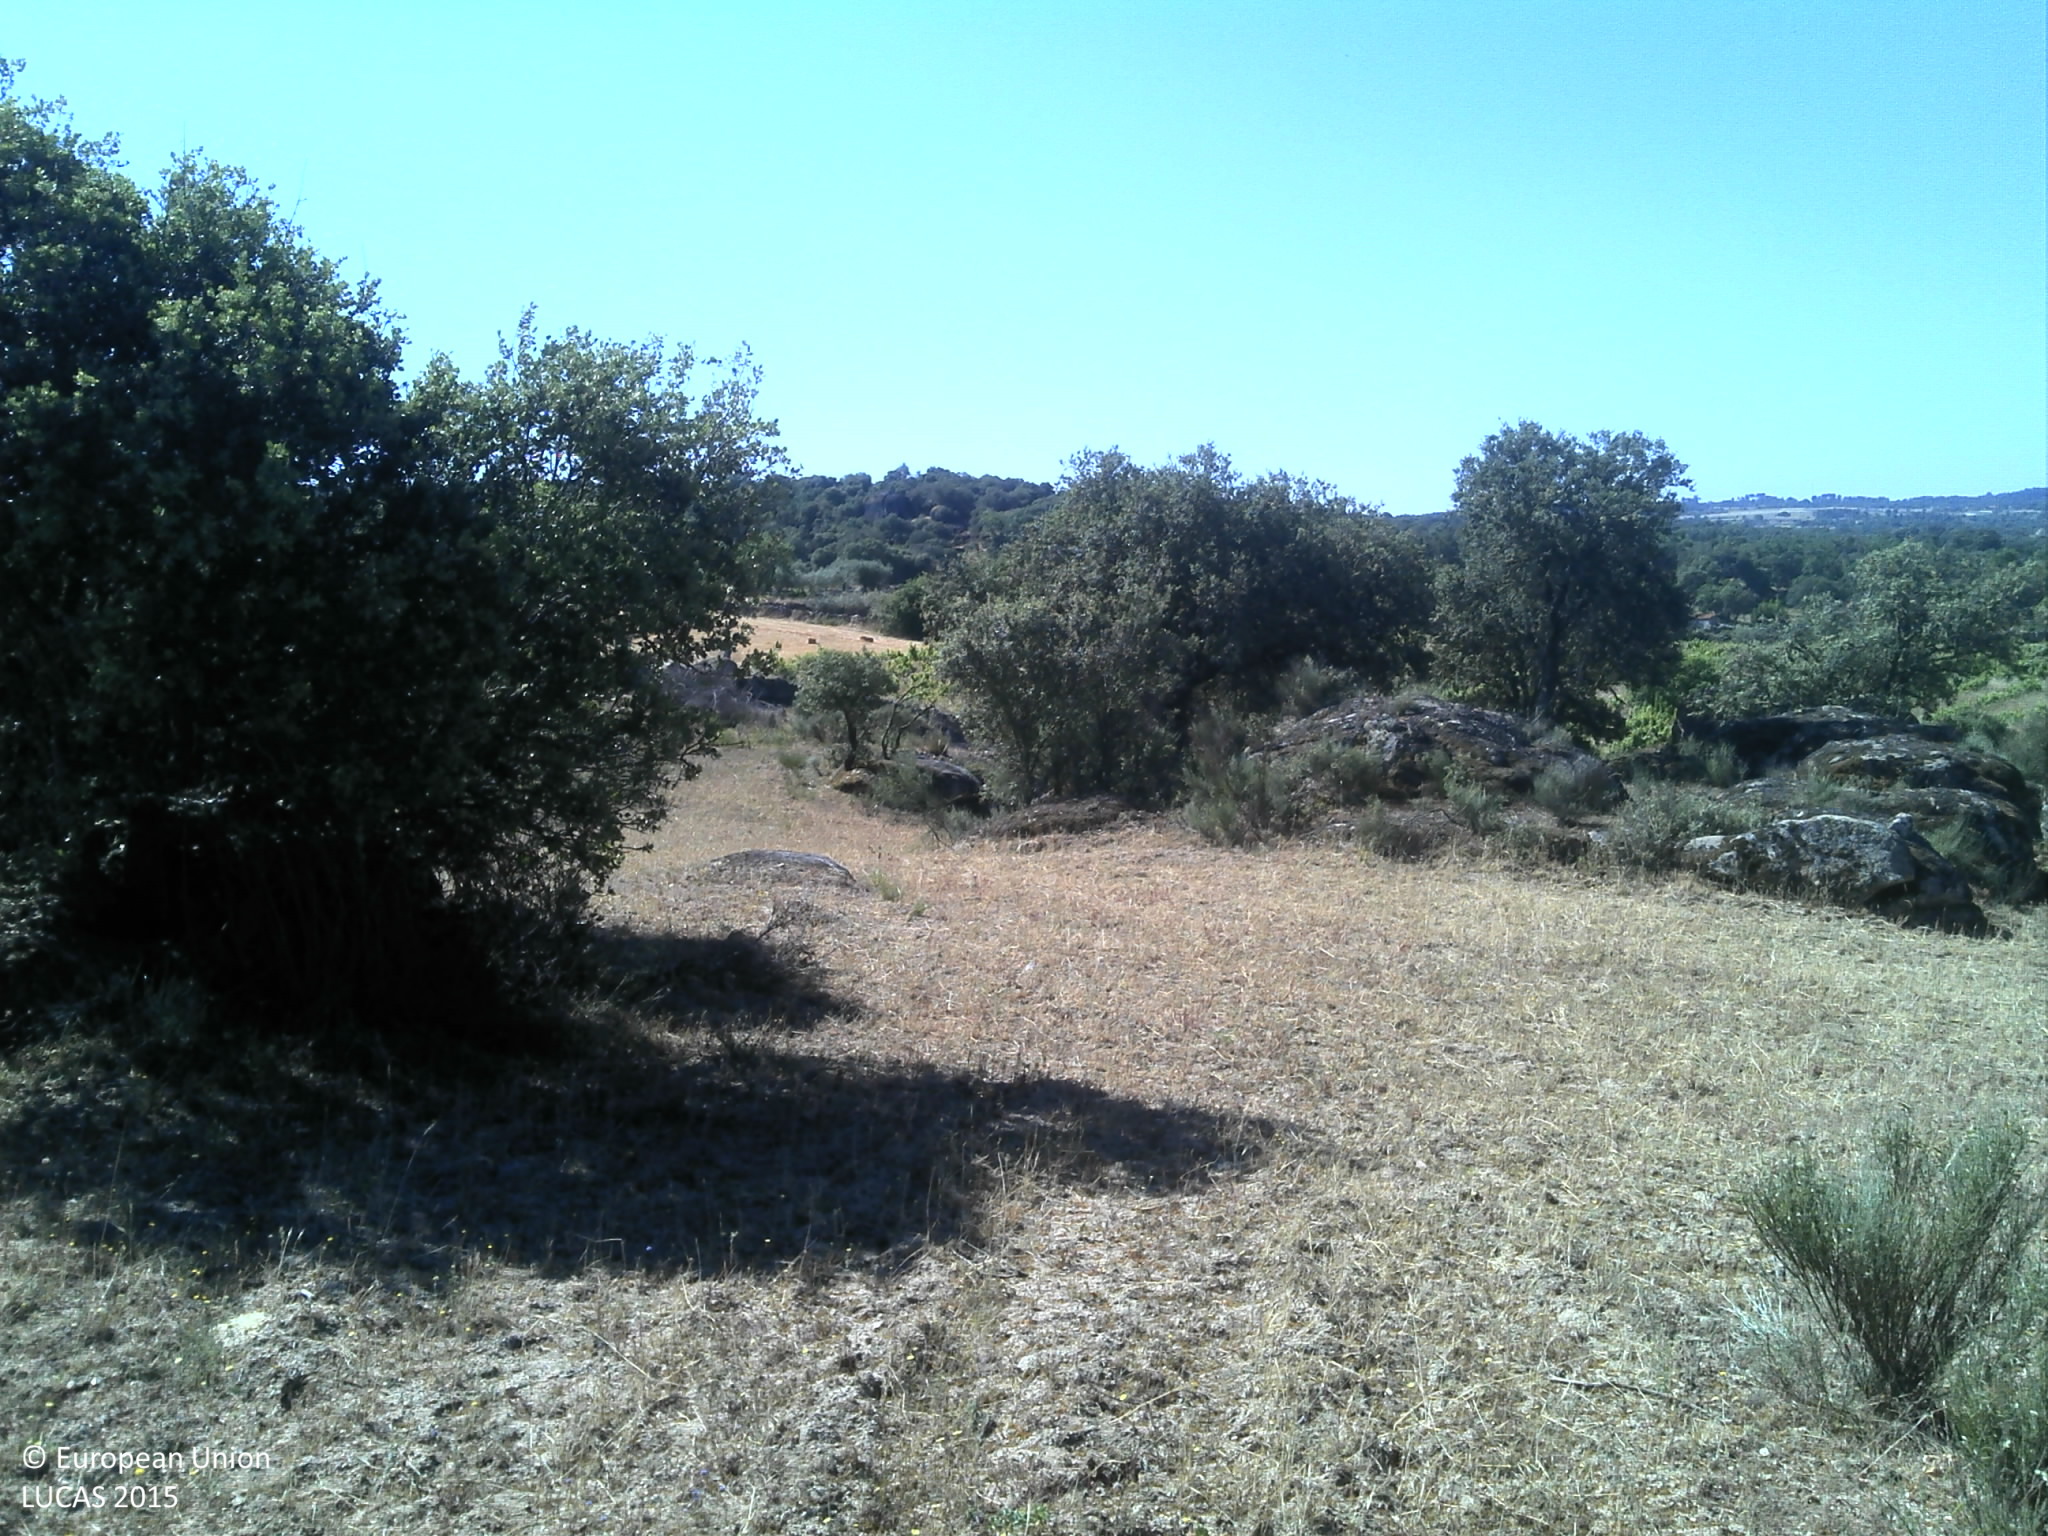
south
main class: Grassland
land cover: Grassland with sparse tree/shrub cover
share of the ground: 50 - 75 %
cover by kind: unconsolidated bare surface 50 %, herbaceous plants 40 %, broadleaved forest trees 5 %, shrubs 5 %
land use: Agriculture (excluding fallow land and kitchen gardens)
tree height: > 5 m
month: June
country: PT
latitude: 40.6516
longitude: -7.0013
